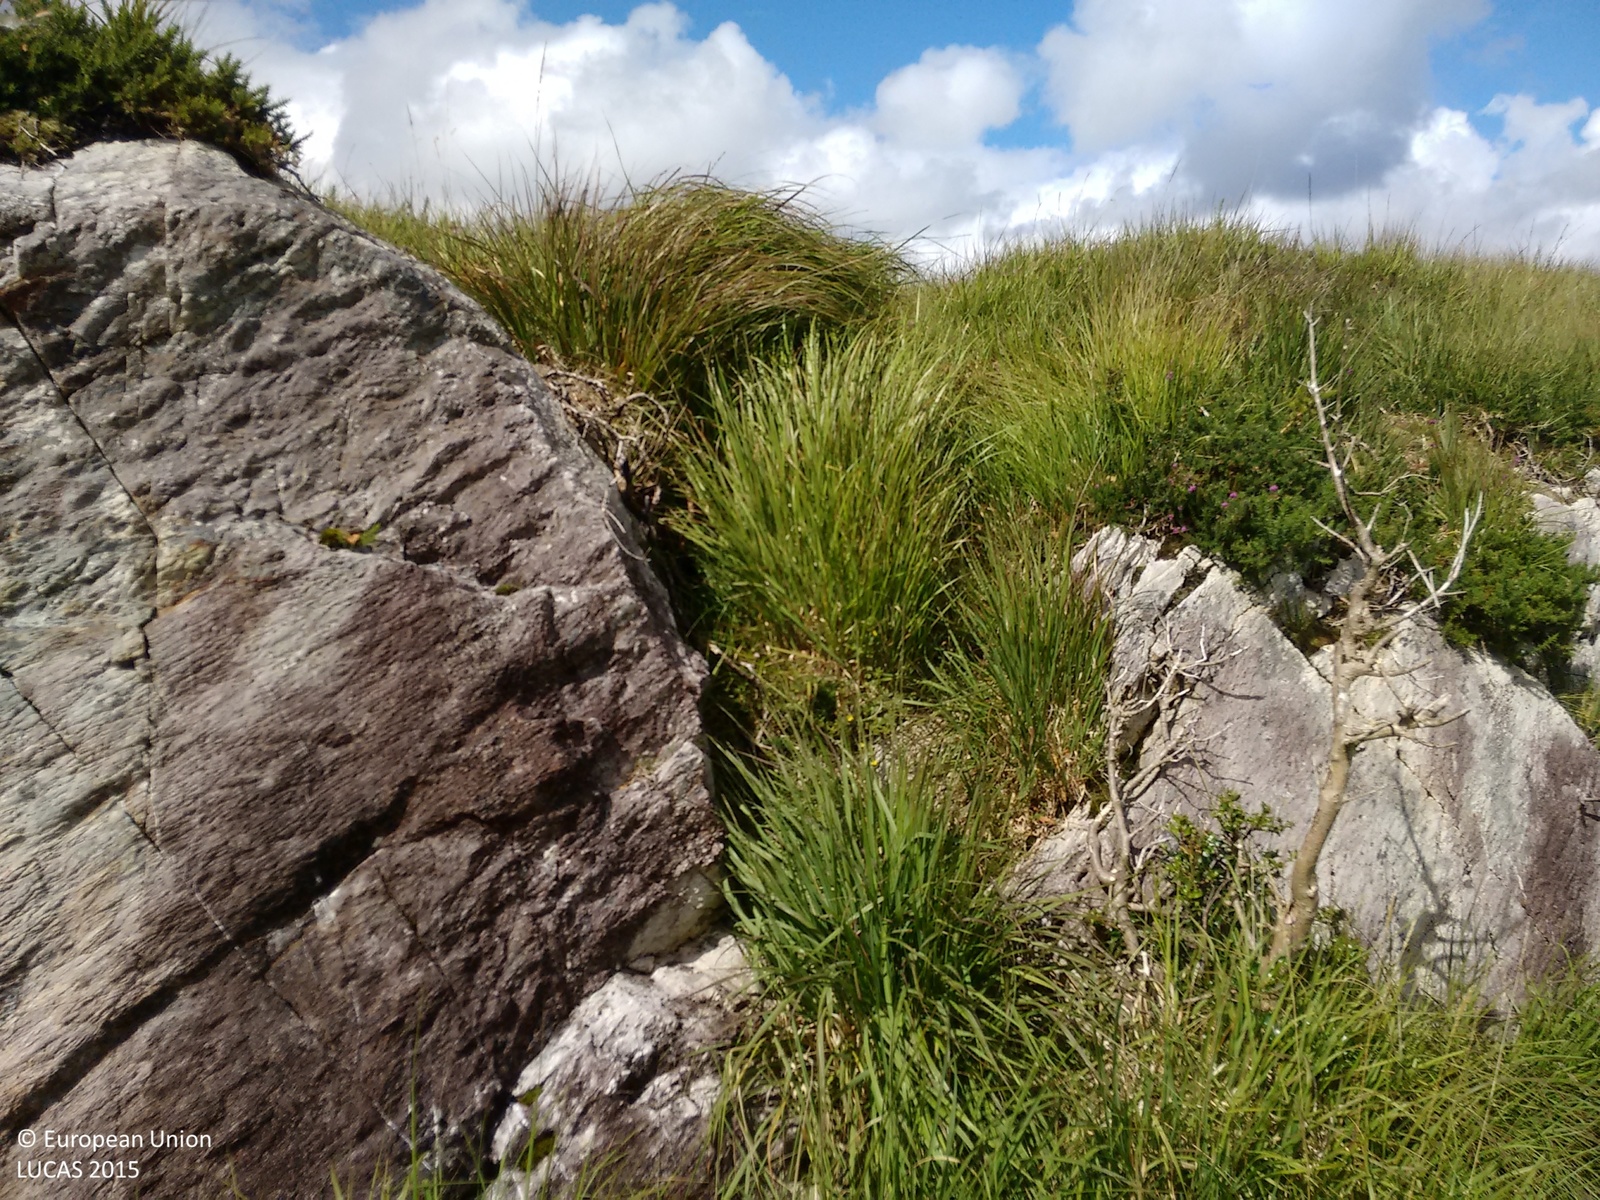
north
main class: Grassland
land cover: Grassland without tree/shrub cover
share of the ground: > 75 %
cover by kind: herbaceous plants 60 %, consolidated bare surface 40 %
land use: Semi-natural and natural areas not in use
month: August
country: IE
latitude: 51.7406
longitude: -9.4786
